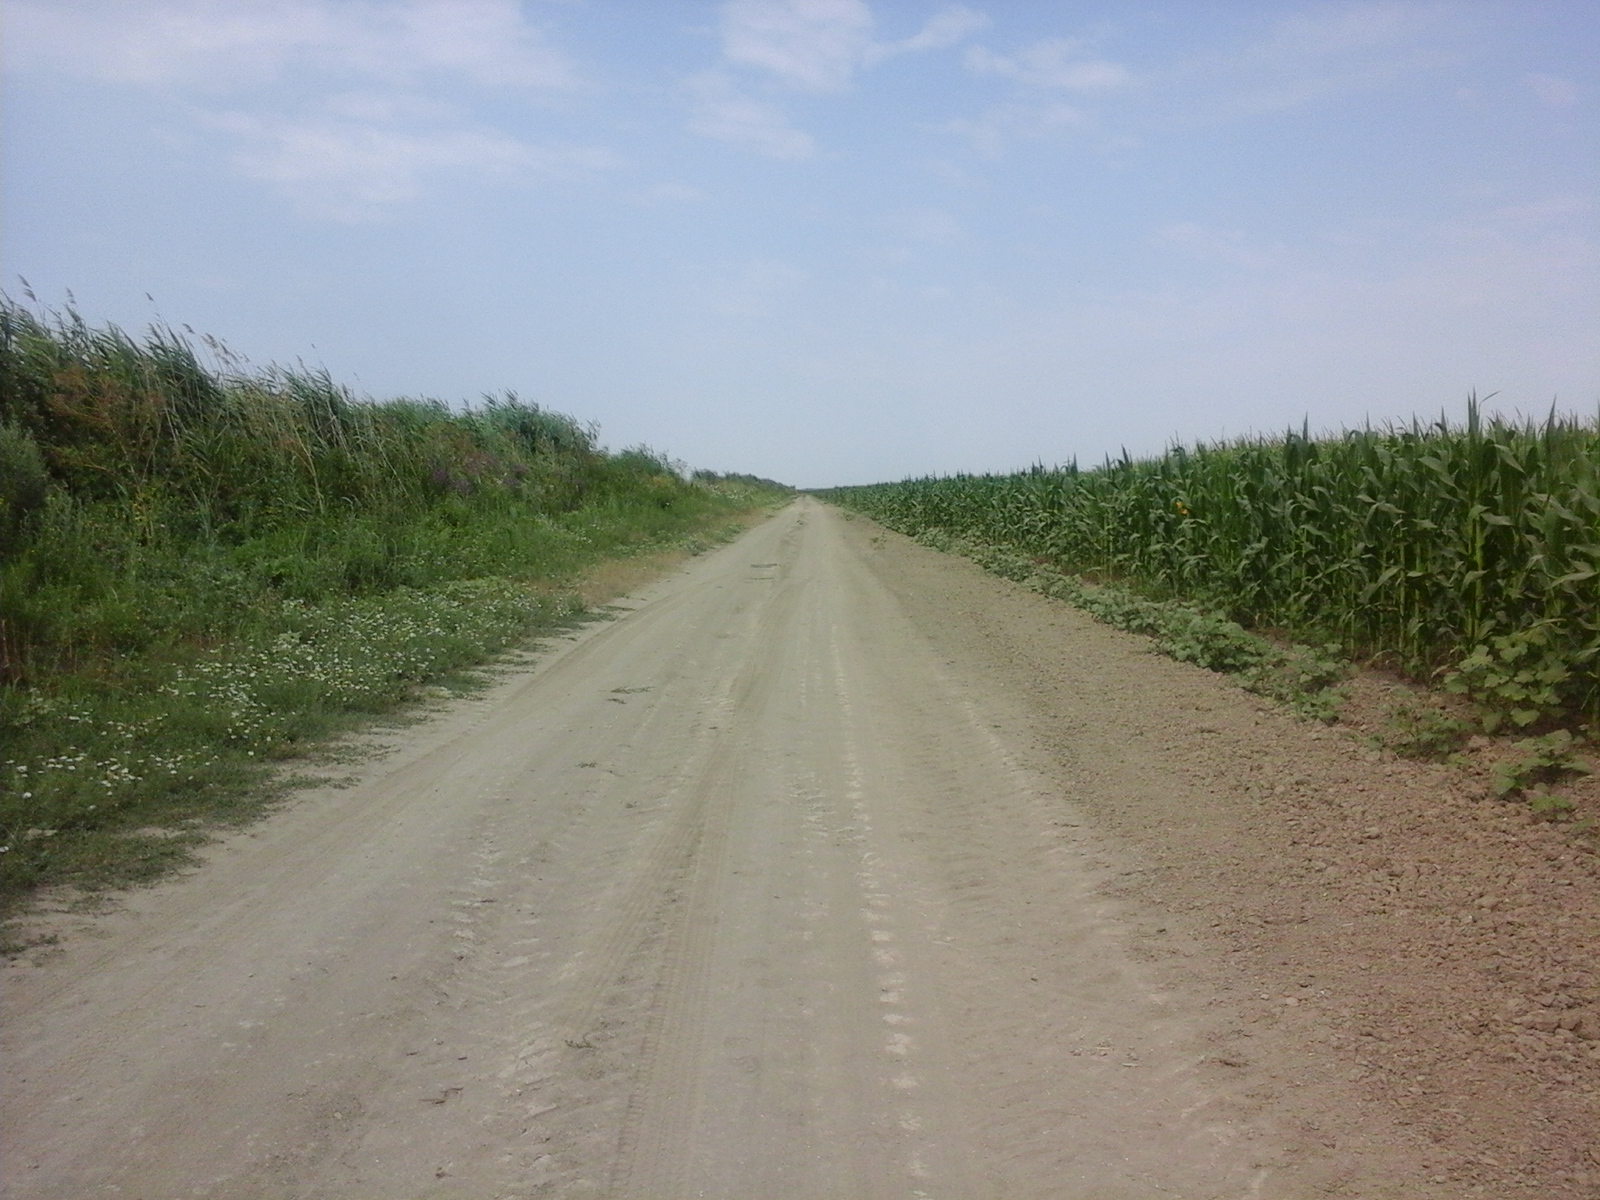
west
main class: Cropland
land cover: Maize
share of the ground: > 75 %
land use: Agriculture (excluding fallow land and kitchen gardens)
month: July
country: RO
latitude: 44.4677
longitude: 28.0461
